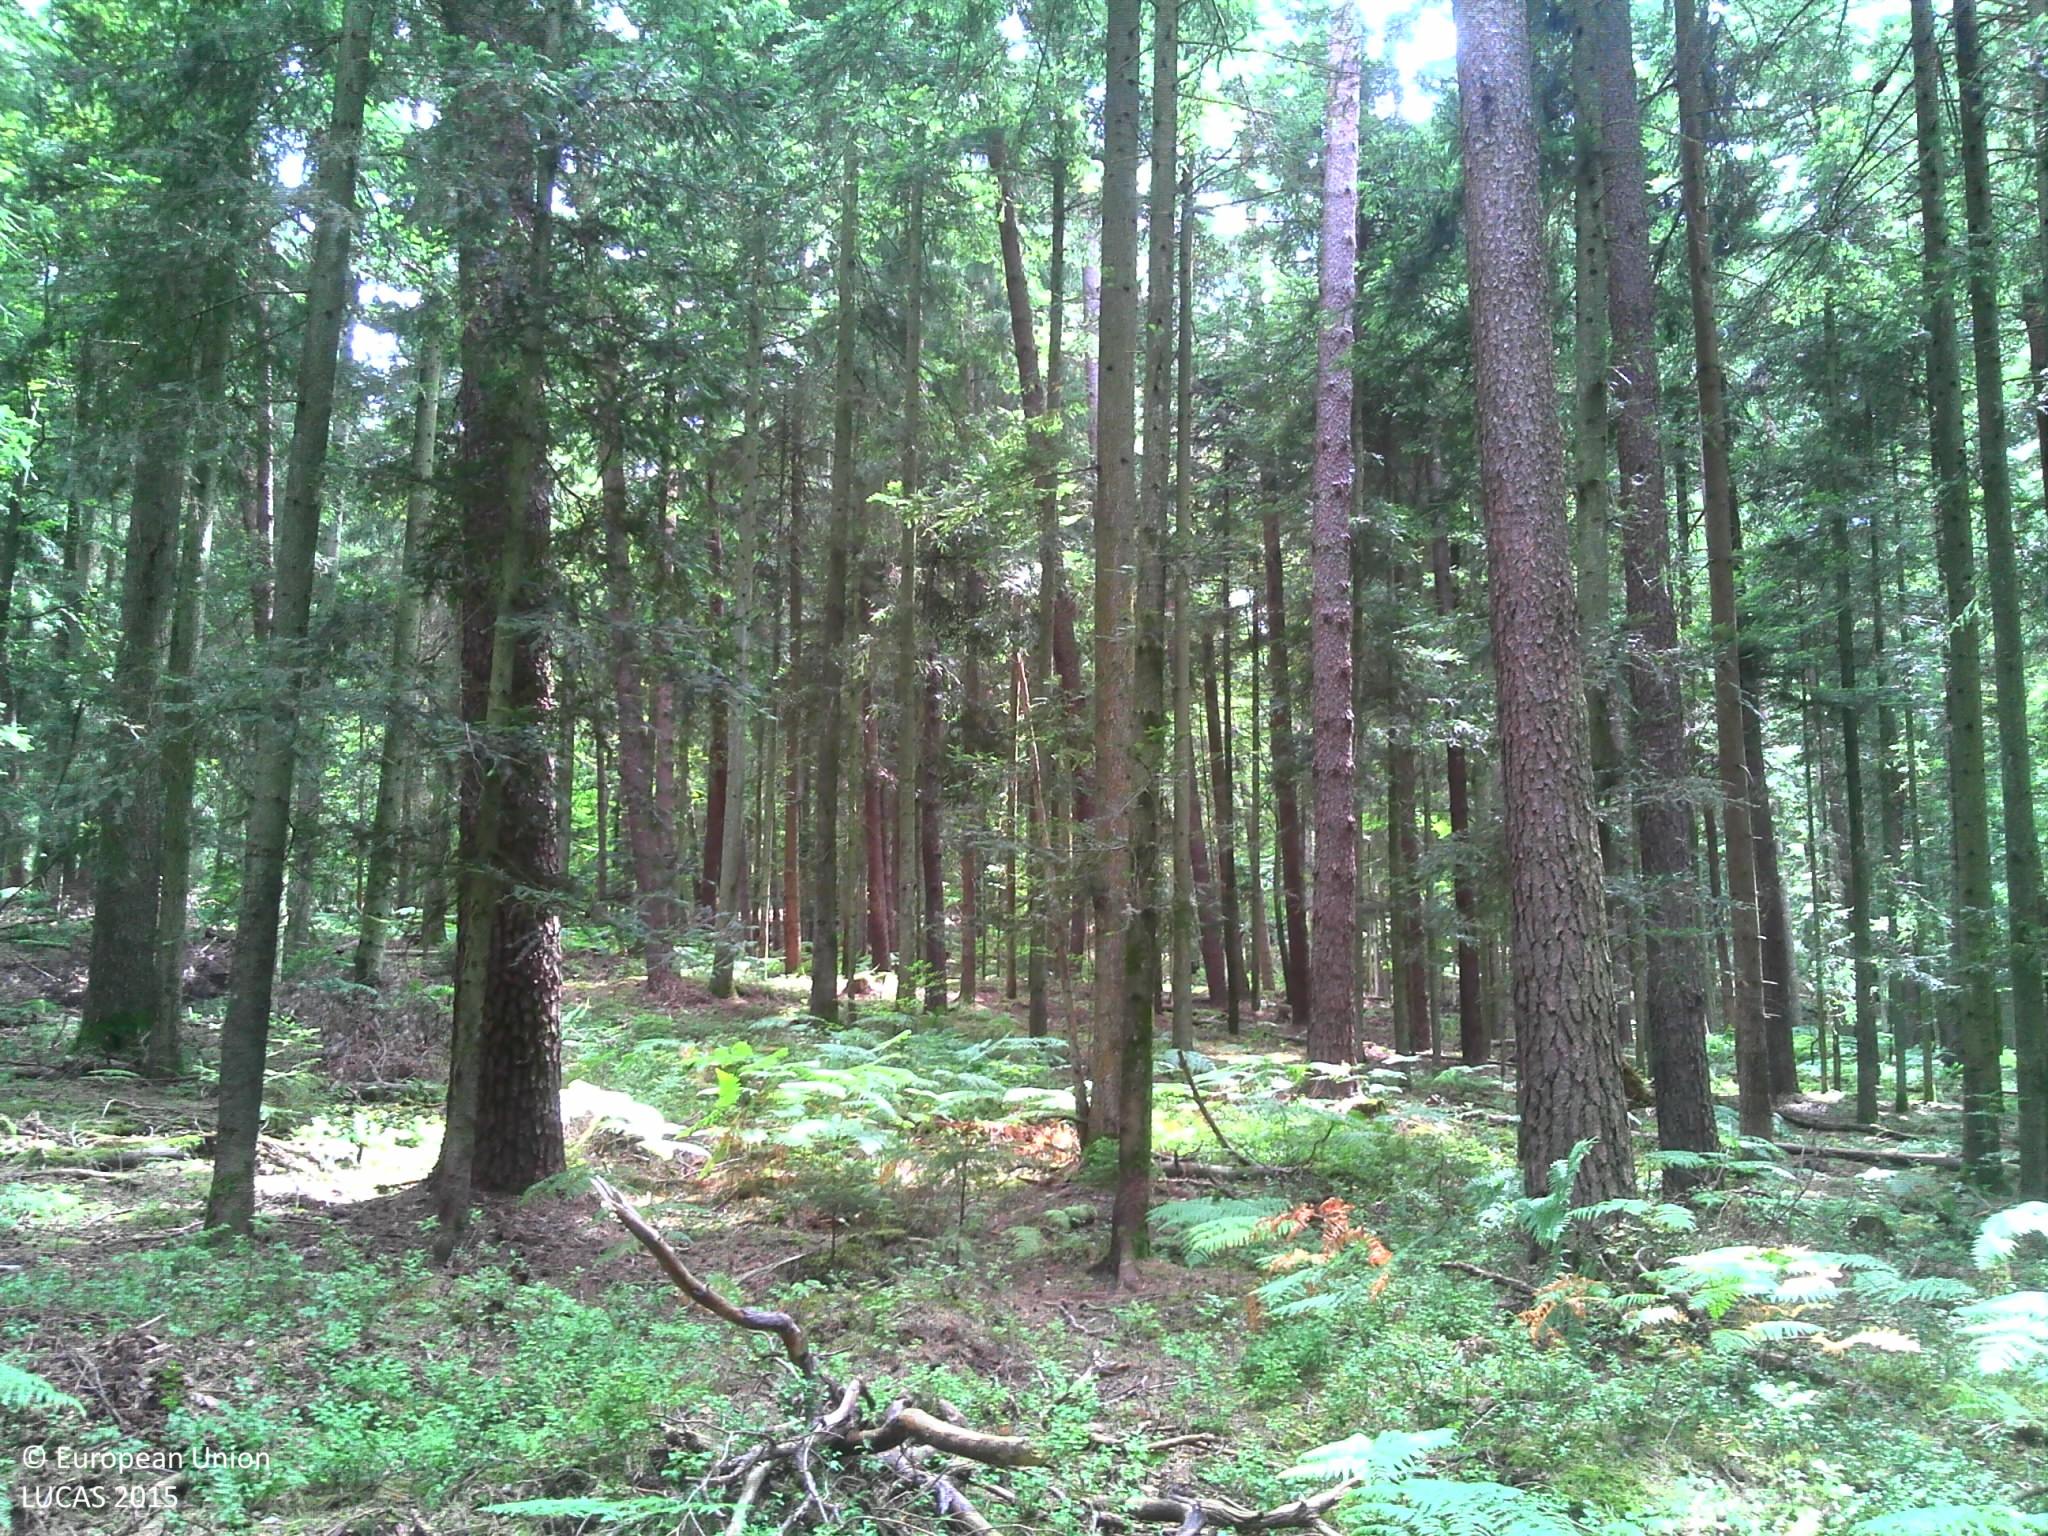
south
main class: Woodland
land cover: Other coniferous woodland
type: hemiboreal forest and nemoral coniferous forest and mixed broadleaved-coniferous forest
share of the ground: > 75 %
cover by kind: coniferous forest trees 85 %, broadleaved forest trees 5 %, herbaceous plants 5 %, lichens and mosses 5 %
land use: Forestry
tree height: > 5 m
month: July
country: FR
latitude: 48.9321
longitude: 7.4480
